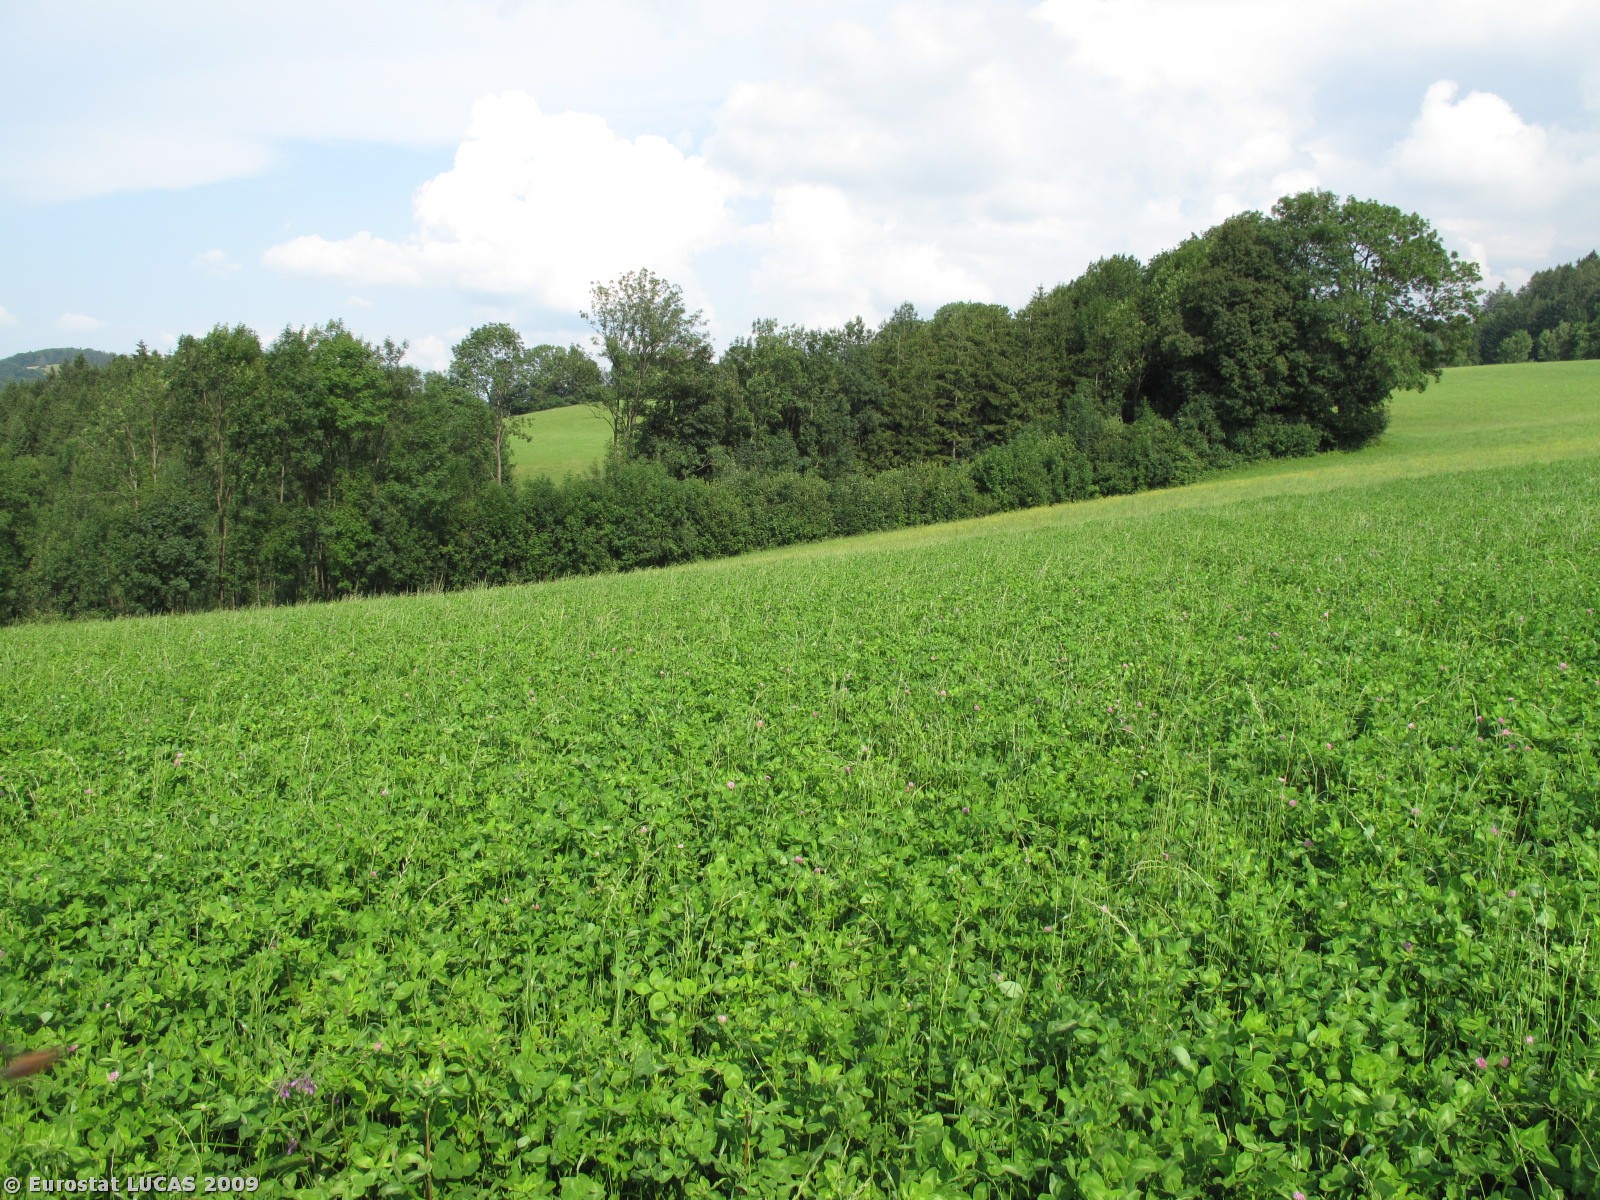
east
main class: Cropland
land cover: Clovers
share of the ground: > 75 %
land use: Agriculture (excluding fallow land and kitchen gardens)
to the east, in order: Clovers; Grassland without tree/shrub cover; Shrubland without tree cover; Broadleaved woodland; Fences; Grassland without tree/shrub cover
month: July
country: AT
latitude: 48.0426
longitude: 15.6495
